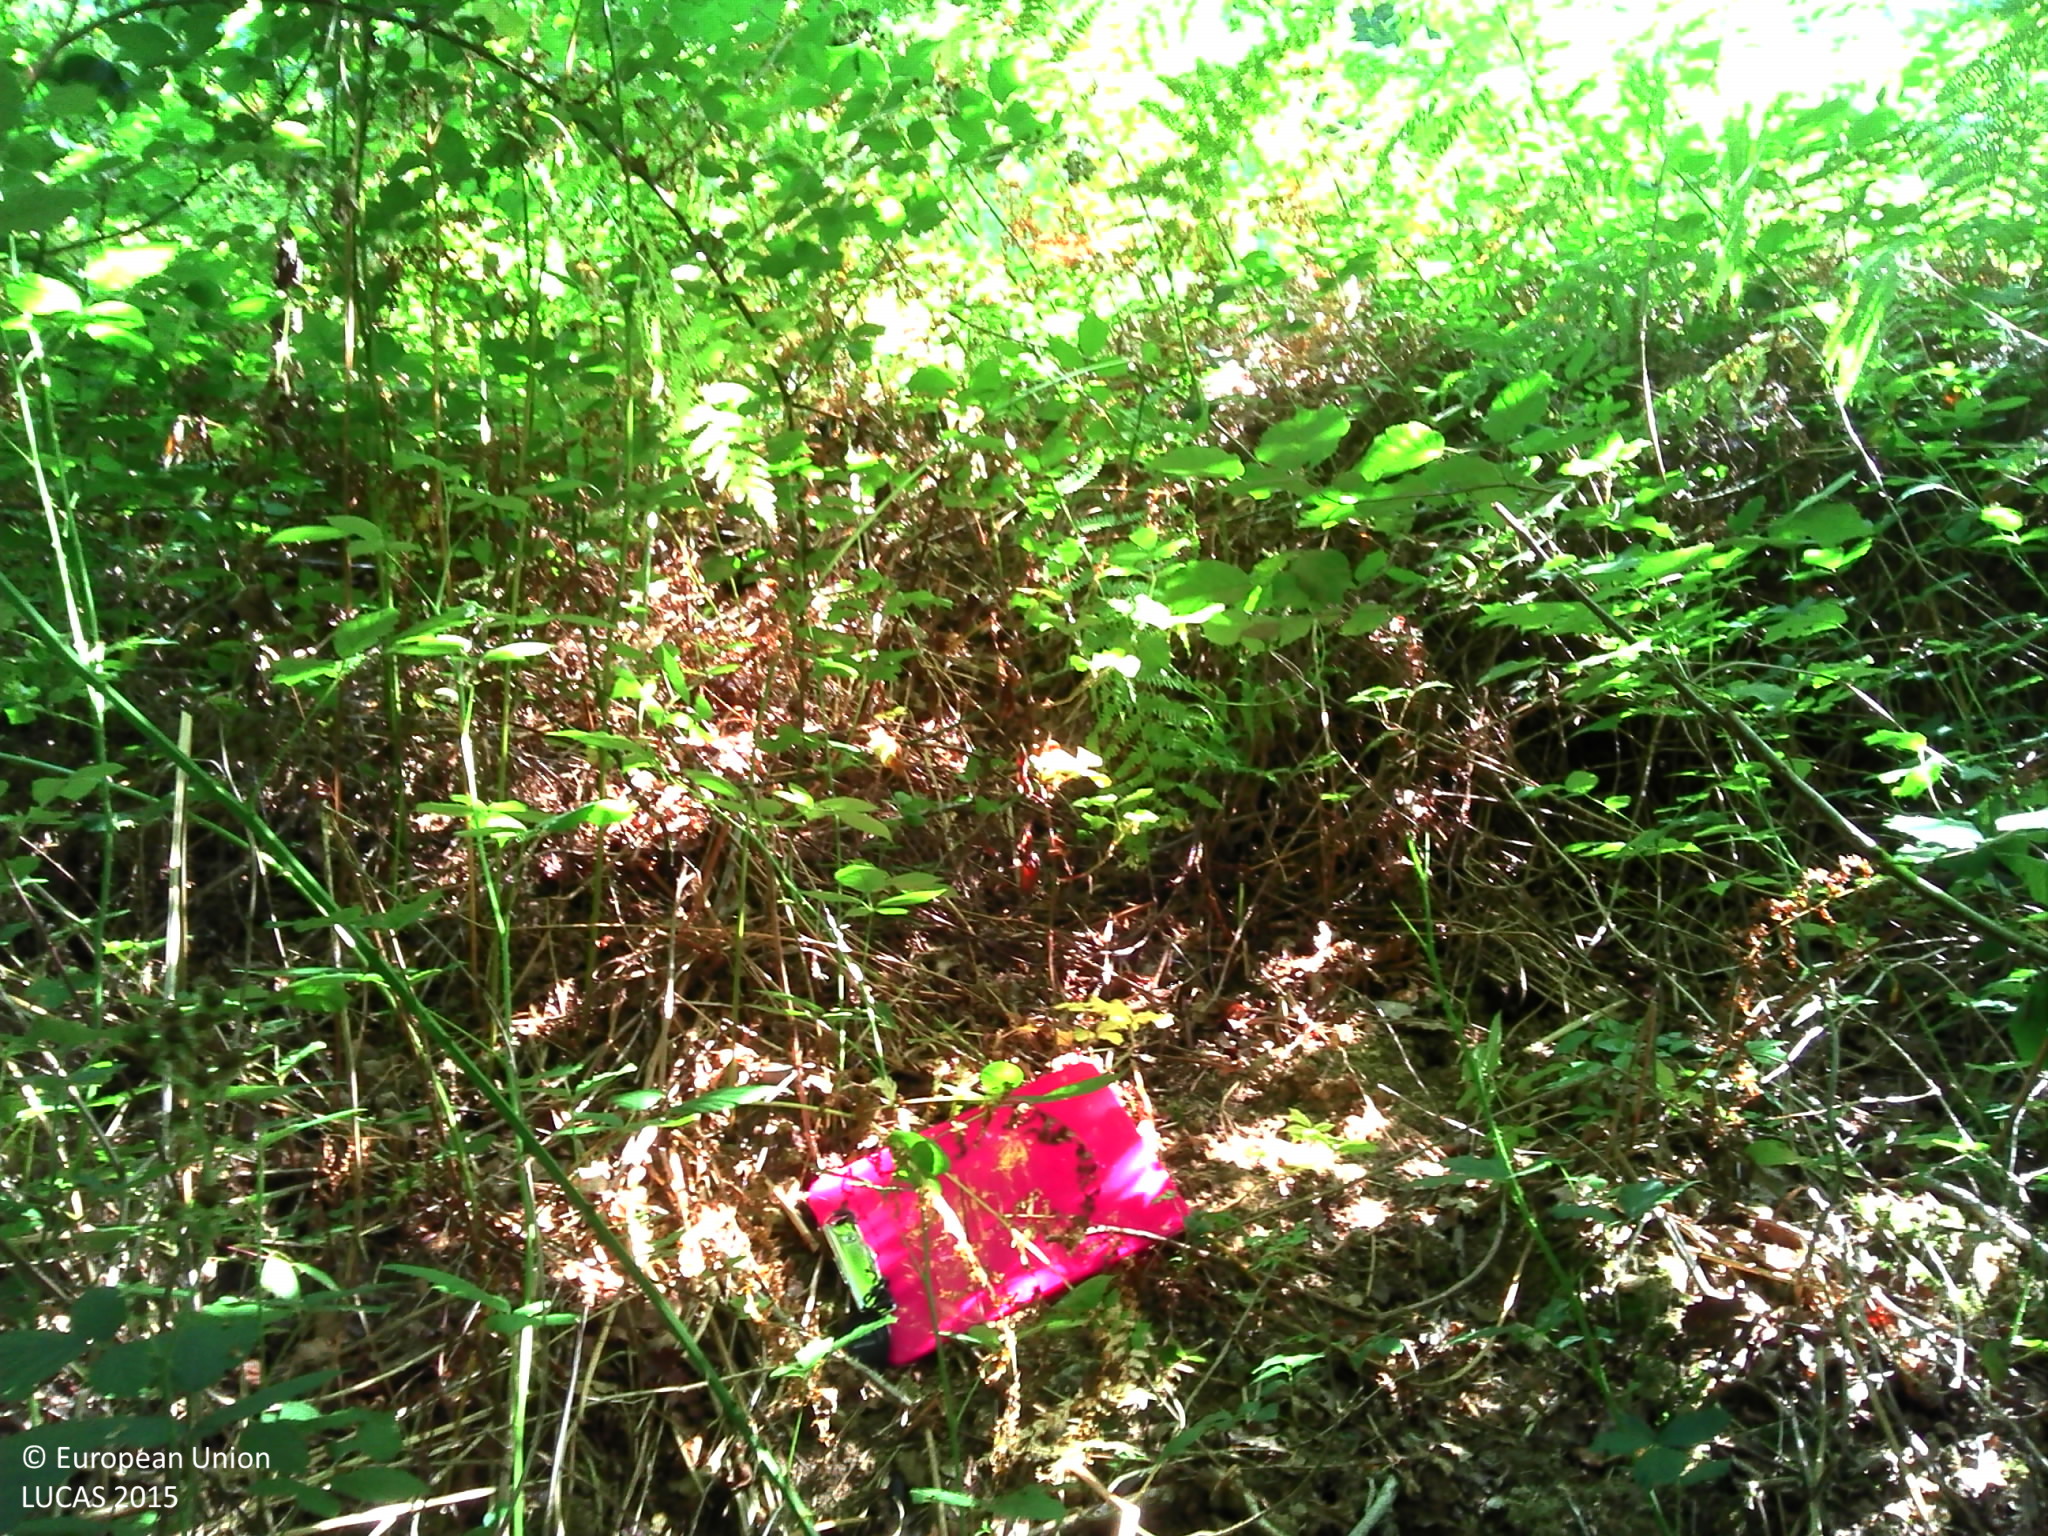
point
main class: Woodland
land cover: Broadleaved woodland
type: acidophilous oak and oak-birch forest
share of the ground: > 75 %
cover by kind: broadleaved forest trees 85 %, herbaceous plants 15 %
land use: Semi-natural and natural areas not in use
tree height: > 5 m
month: July
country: FR
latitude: 43.0204
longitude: 1.0588
